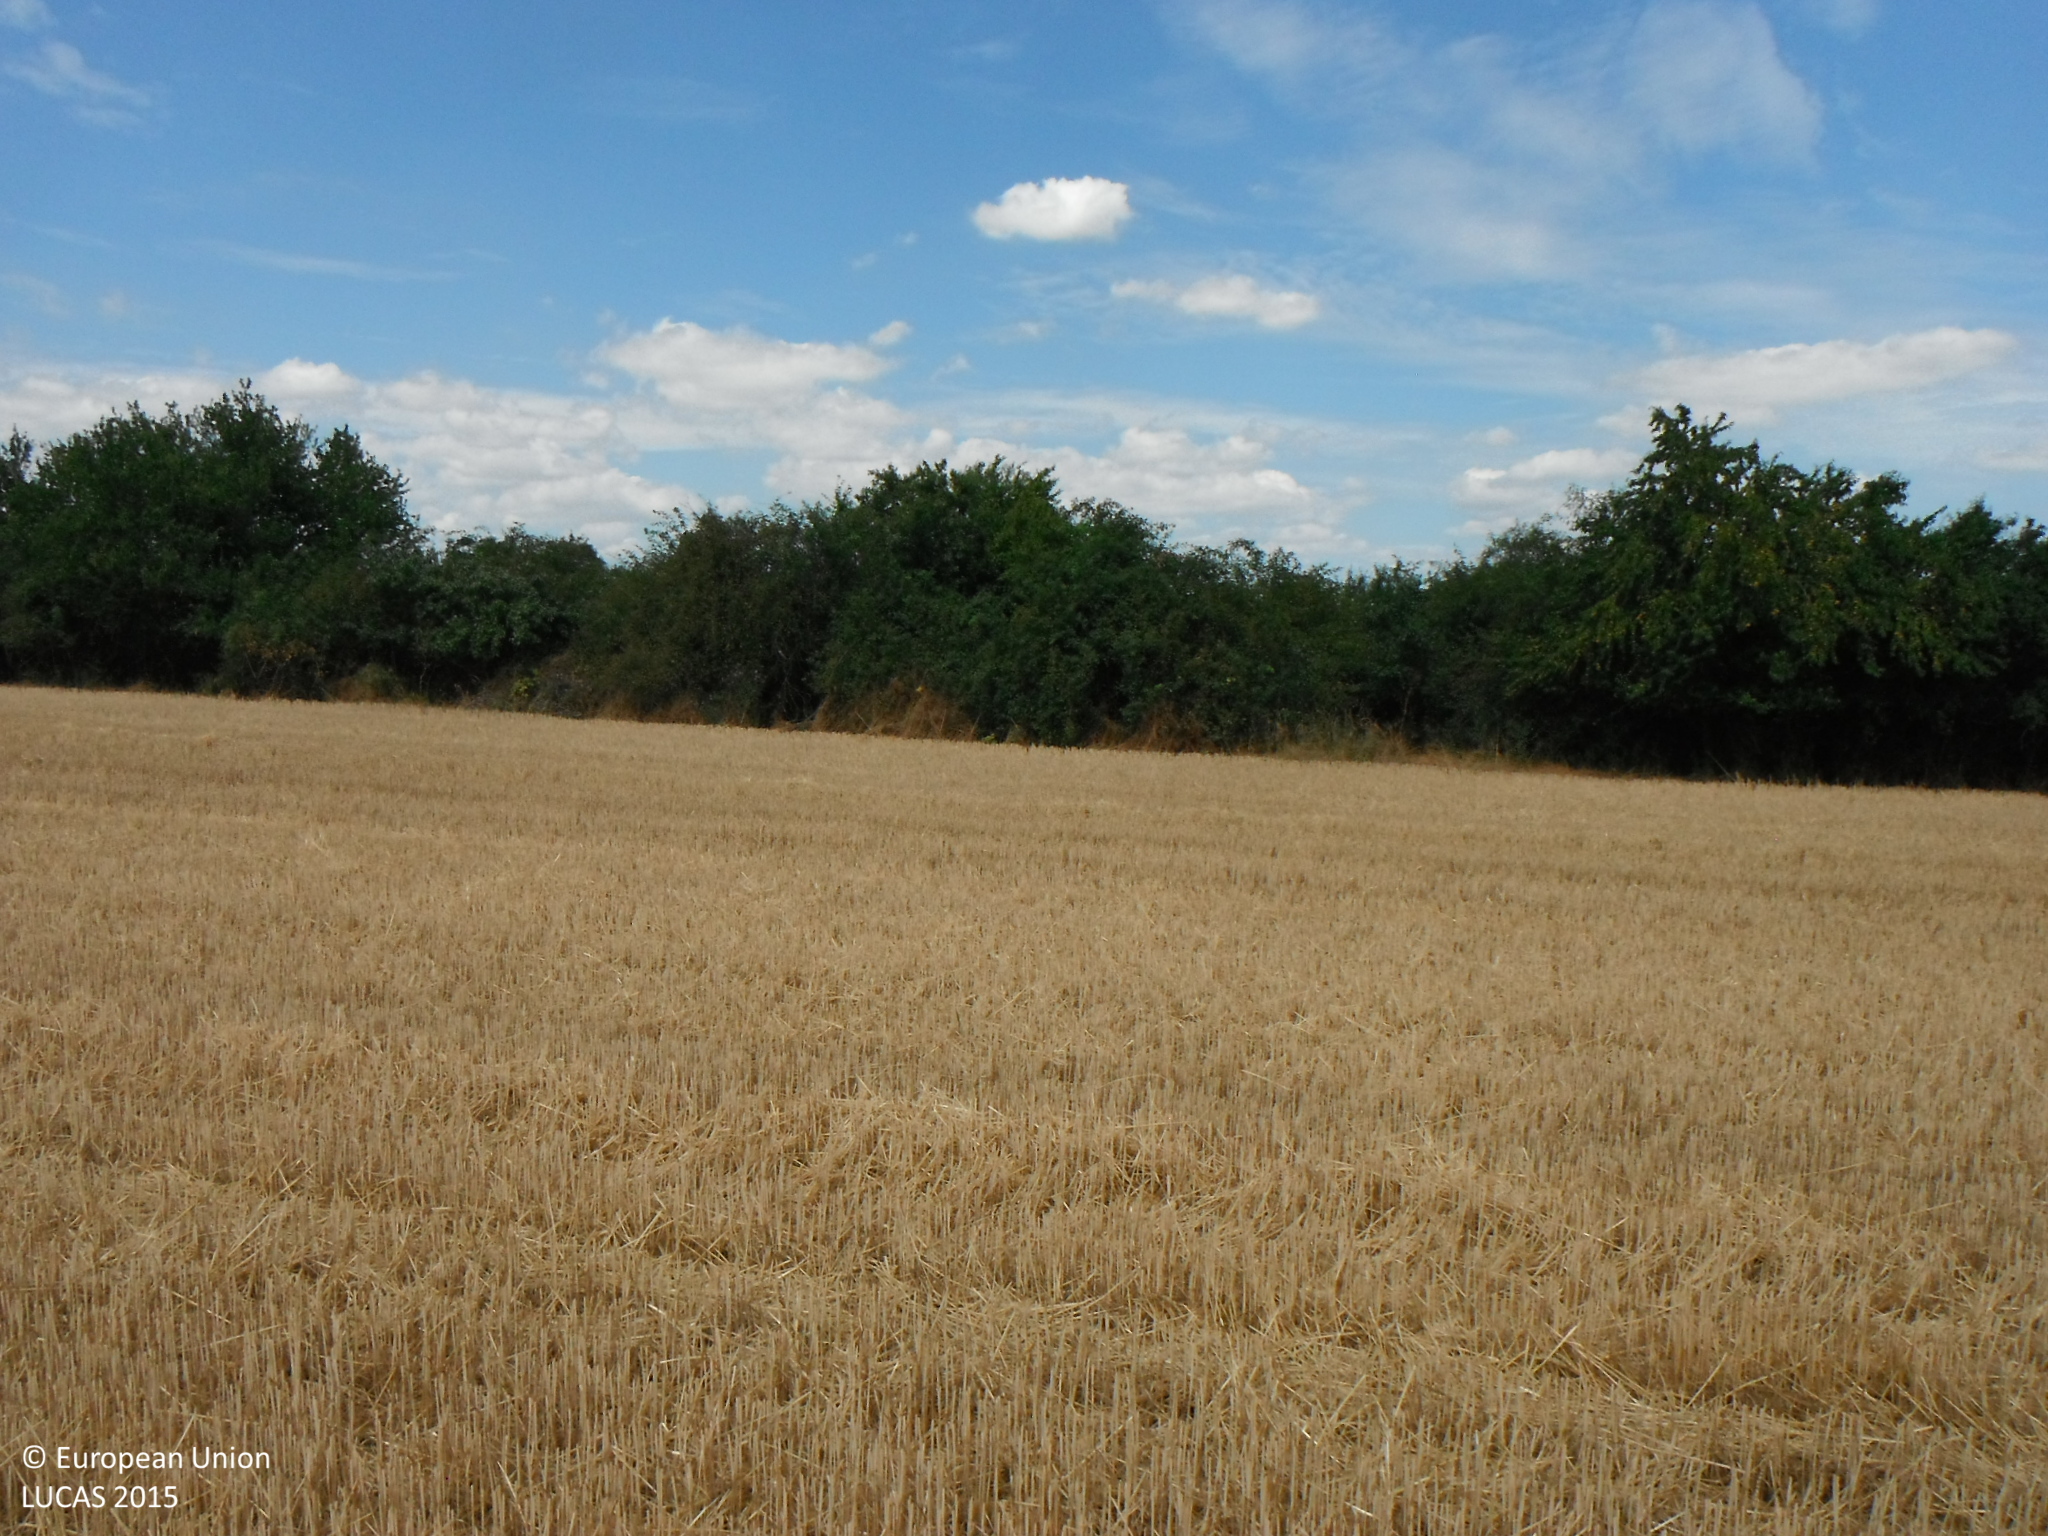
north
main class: Cropland
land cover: Common wheat
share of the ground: > 75 %
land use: Agriculture (excluding fallow land and kitchen gardens)
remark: Harvested field
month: July
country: SK
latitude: 48.1488
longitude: 18.2537
